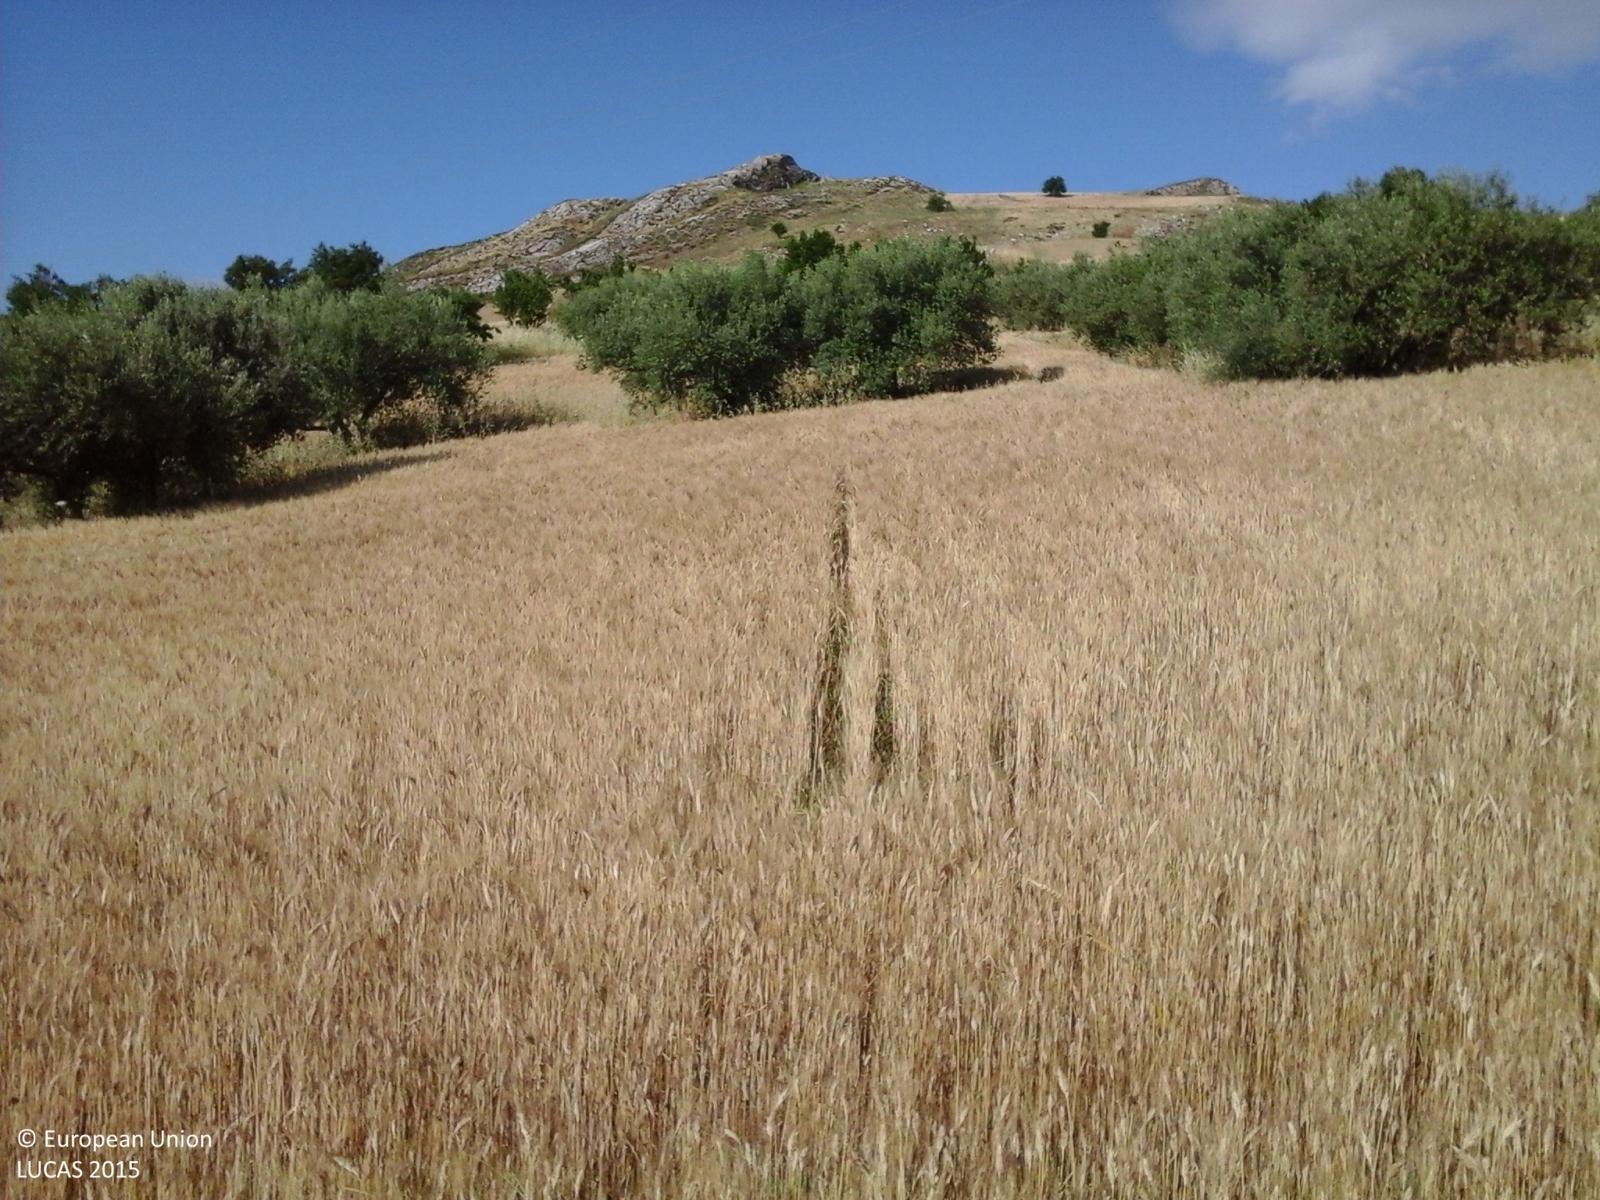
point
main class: Cropland
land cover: Durum wheat
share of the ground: > 75 %
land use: Agriculture (excluding fallow land and kitchen gardens)
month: June
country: IT
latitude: 37.5720
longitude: 14.0124
